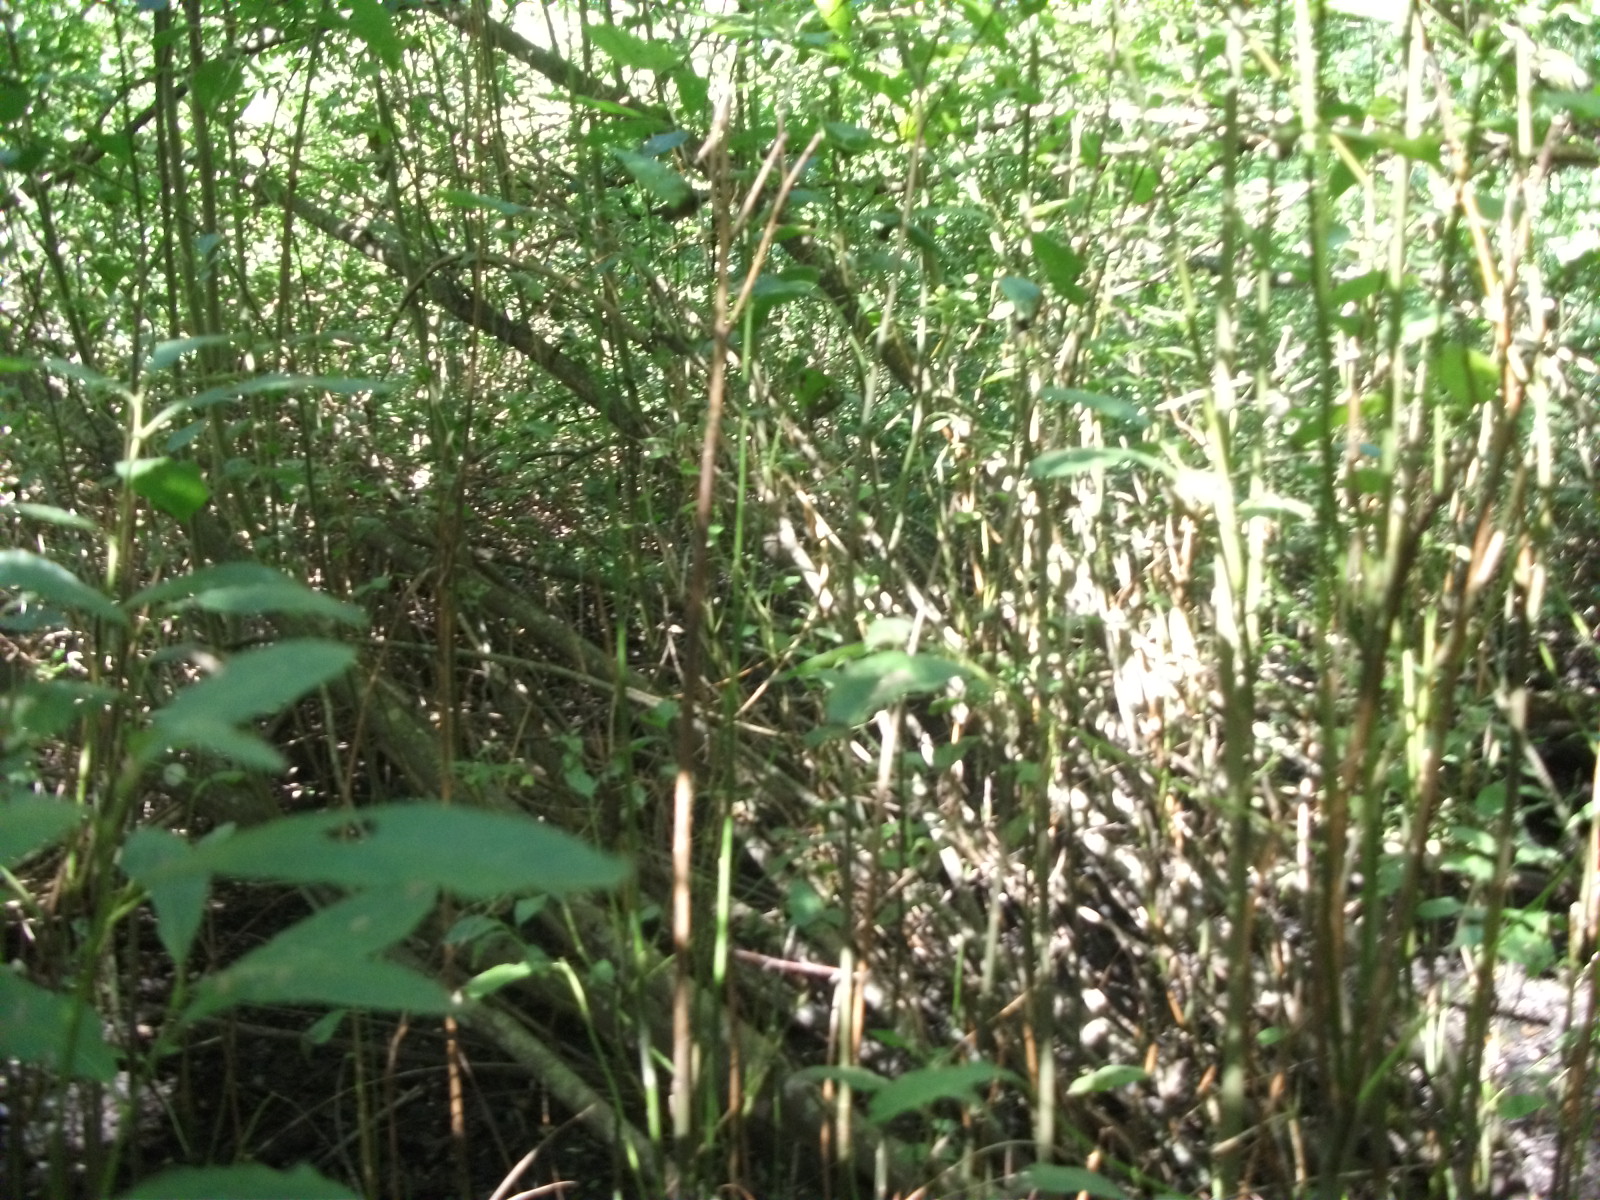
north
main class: Woodland
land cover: Broadleaved woodland
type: mire and swamp forests
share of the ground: 50 - 75 %
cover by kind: broadleaved forest trees 50 %, shrubs 50 %
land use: Forestry
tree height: < 5 m
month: August
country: LV
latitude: 56.6458
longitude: 26.1348
